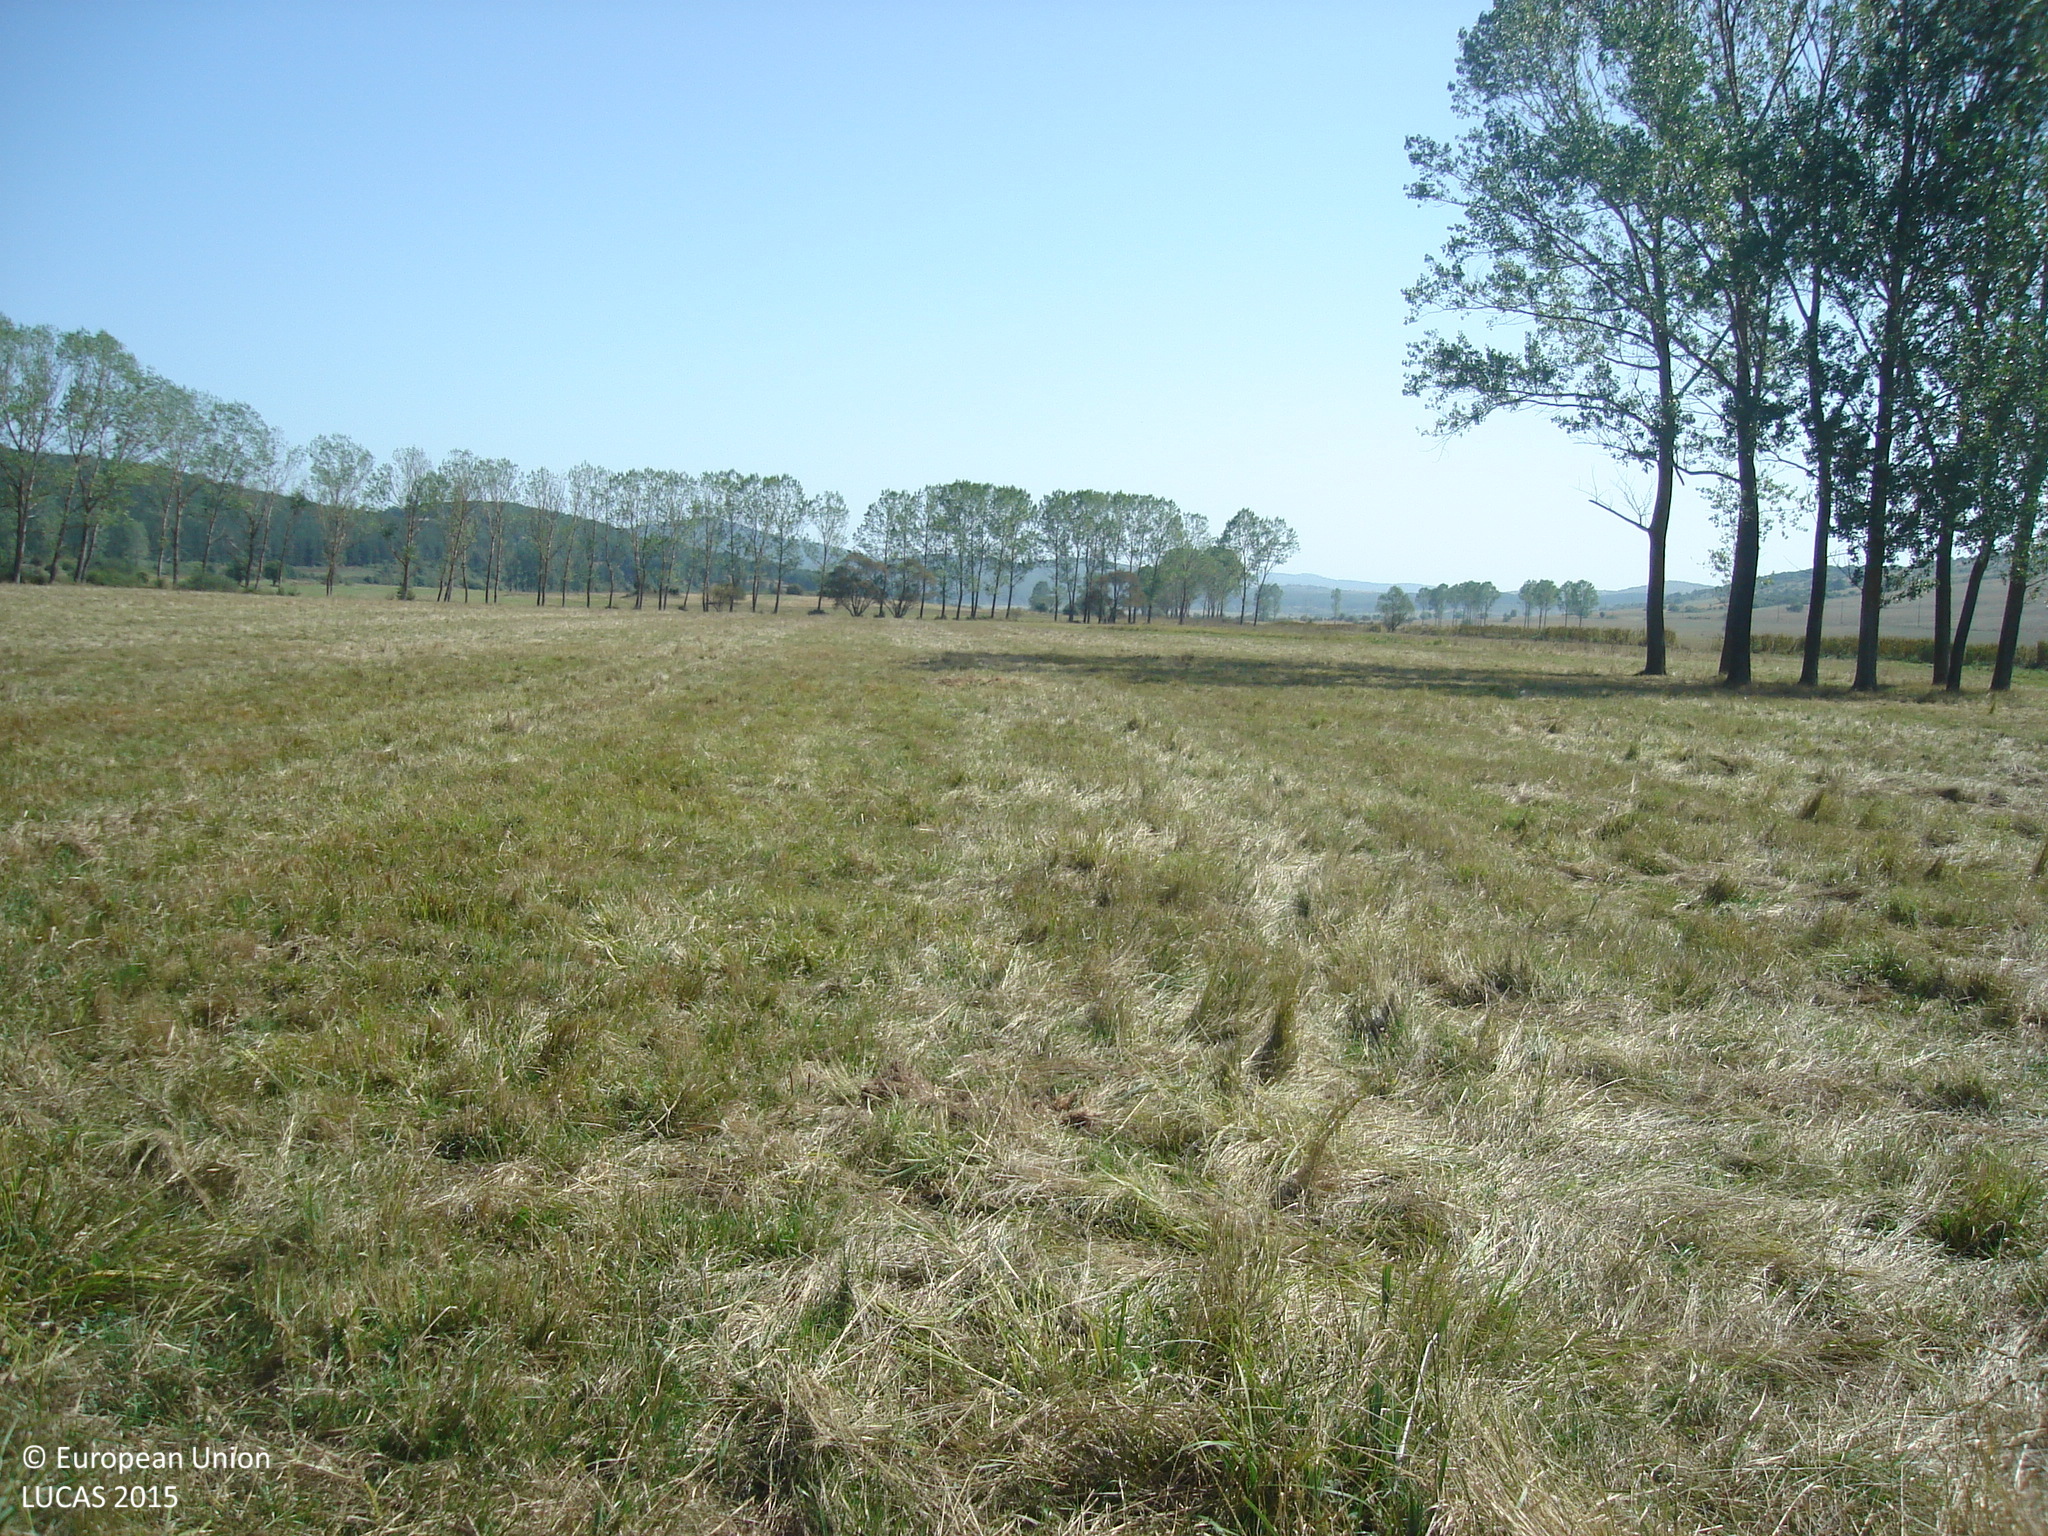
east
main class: Grassland
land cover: Grassland without tree/shrub cover
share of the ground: > 75 %
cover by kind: herbaceous plants 100 %
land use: Agriculture (excluding fallow land and kitchen gardens)
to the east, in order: Grassland without tree/shrub cover
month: September
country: BG
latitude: 42.9485
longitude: 23.1114
